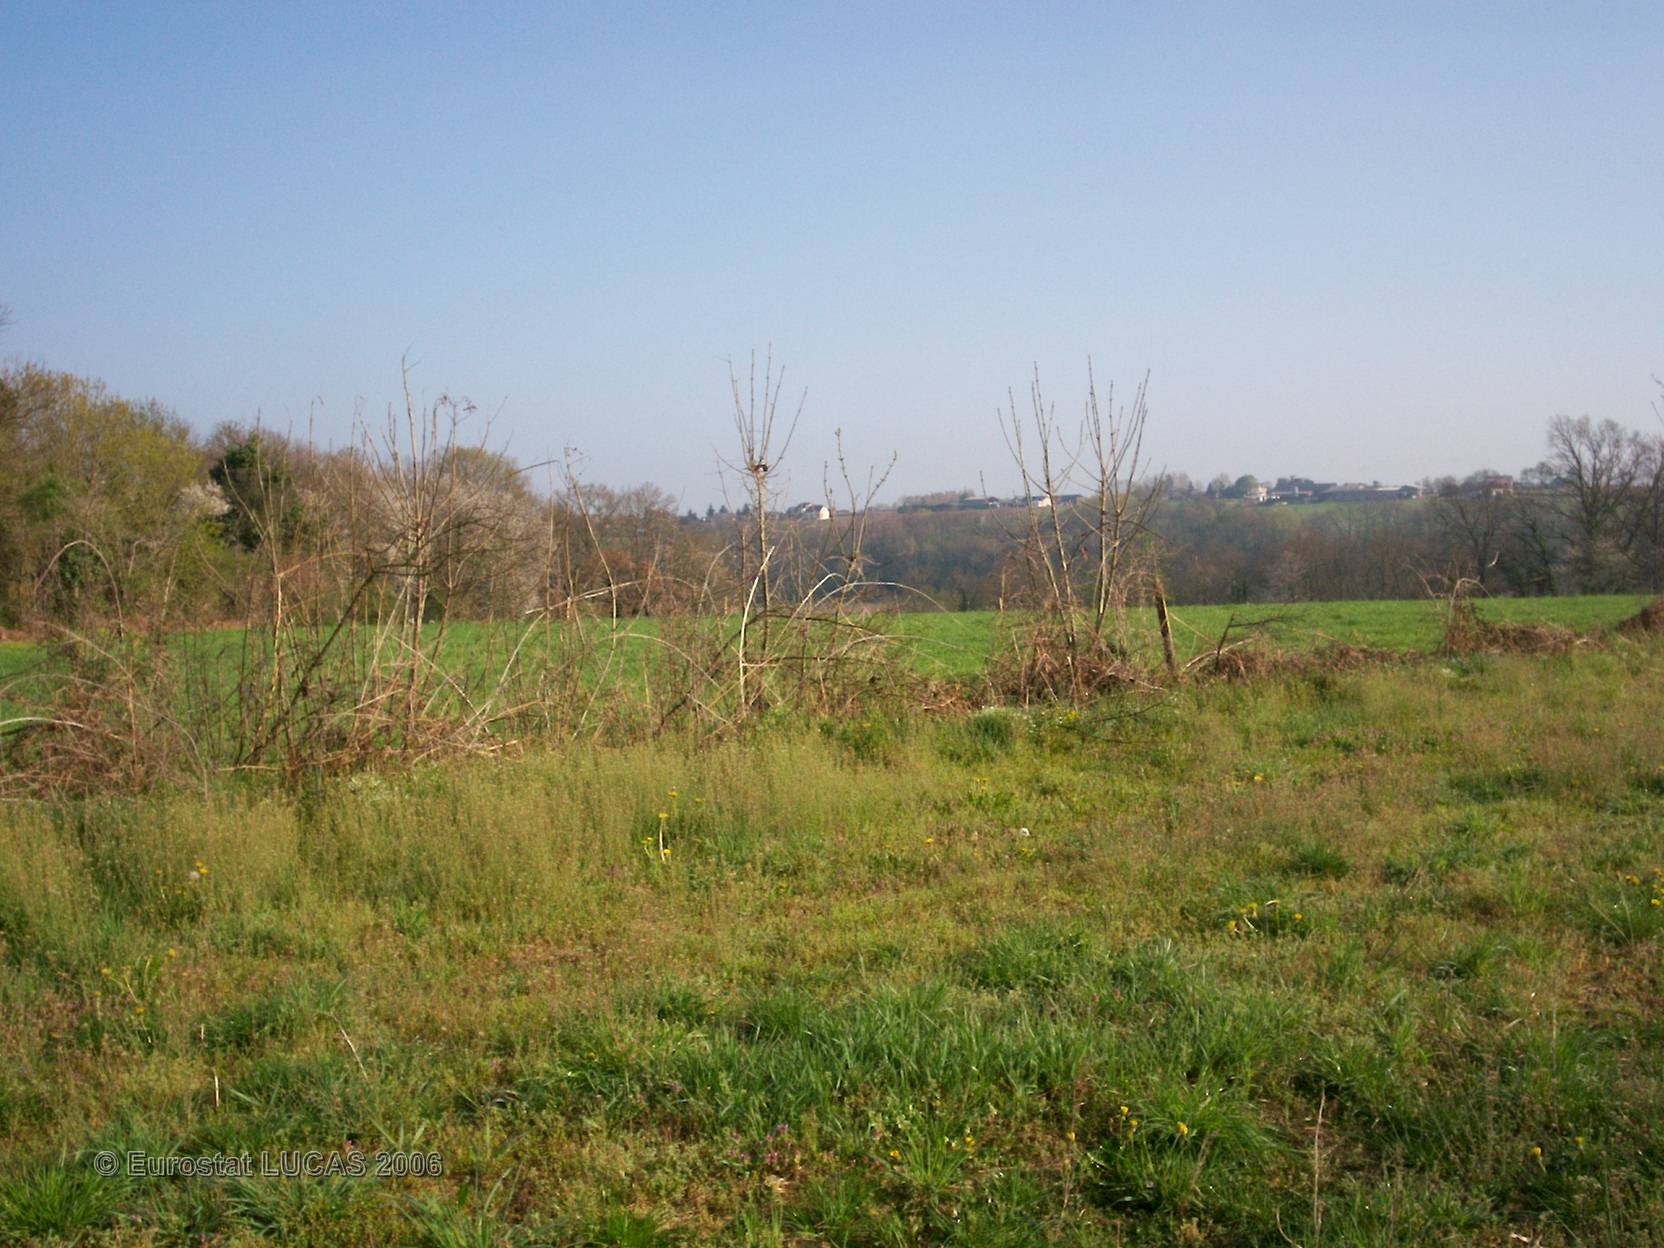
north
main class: Grassland
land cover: Grassland without tree/shrub cover
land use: Fallow land
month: April
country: FR
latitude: 43.2885
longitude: -0.1481
